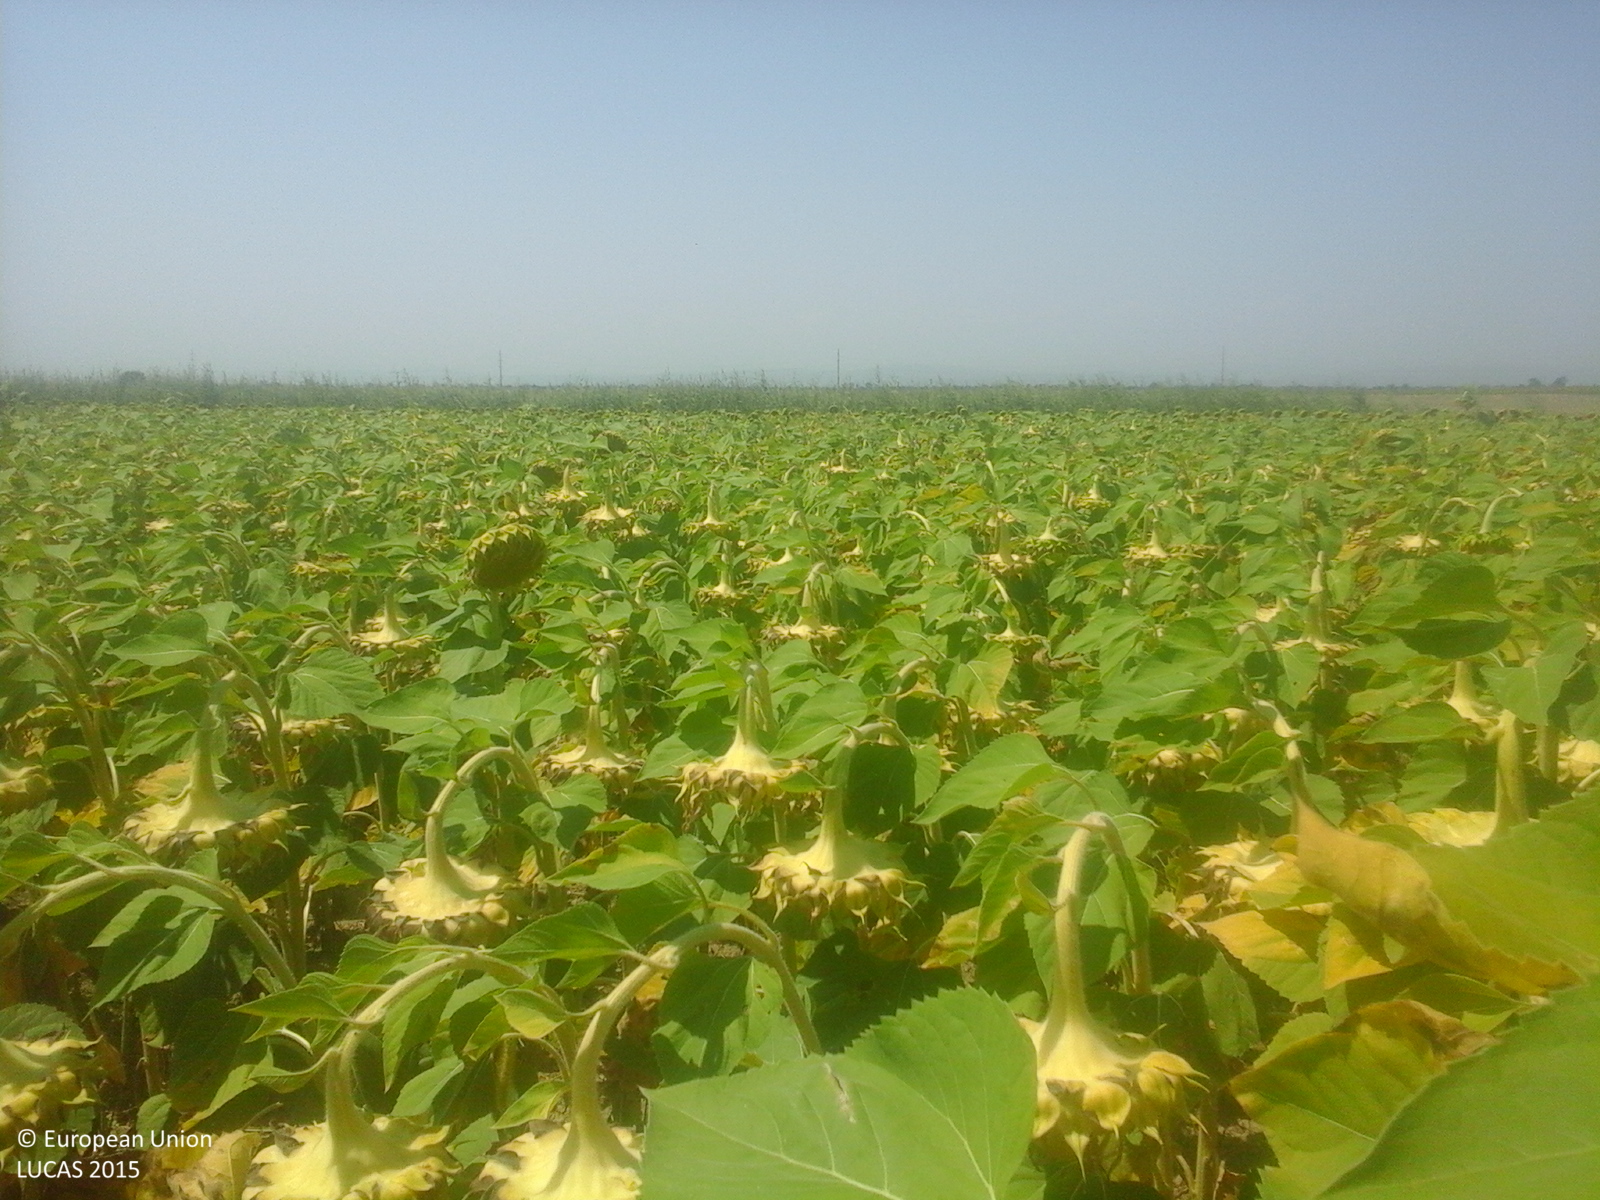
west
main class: Cropland
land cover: Sunflower
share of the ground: > 75 %
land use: Agriculture (excluding fallow land and kitchen gardens)
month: August
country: RO
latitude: 45.5451
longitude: 27.3505
